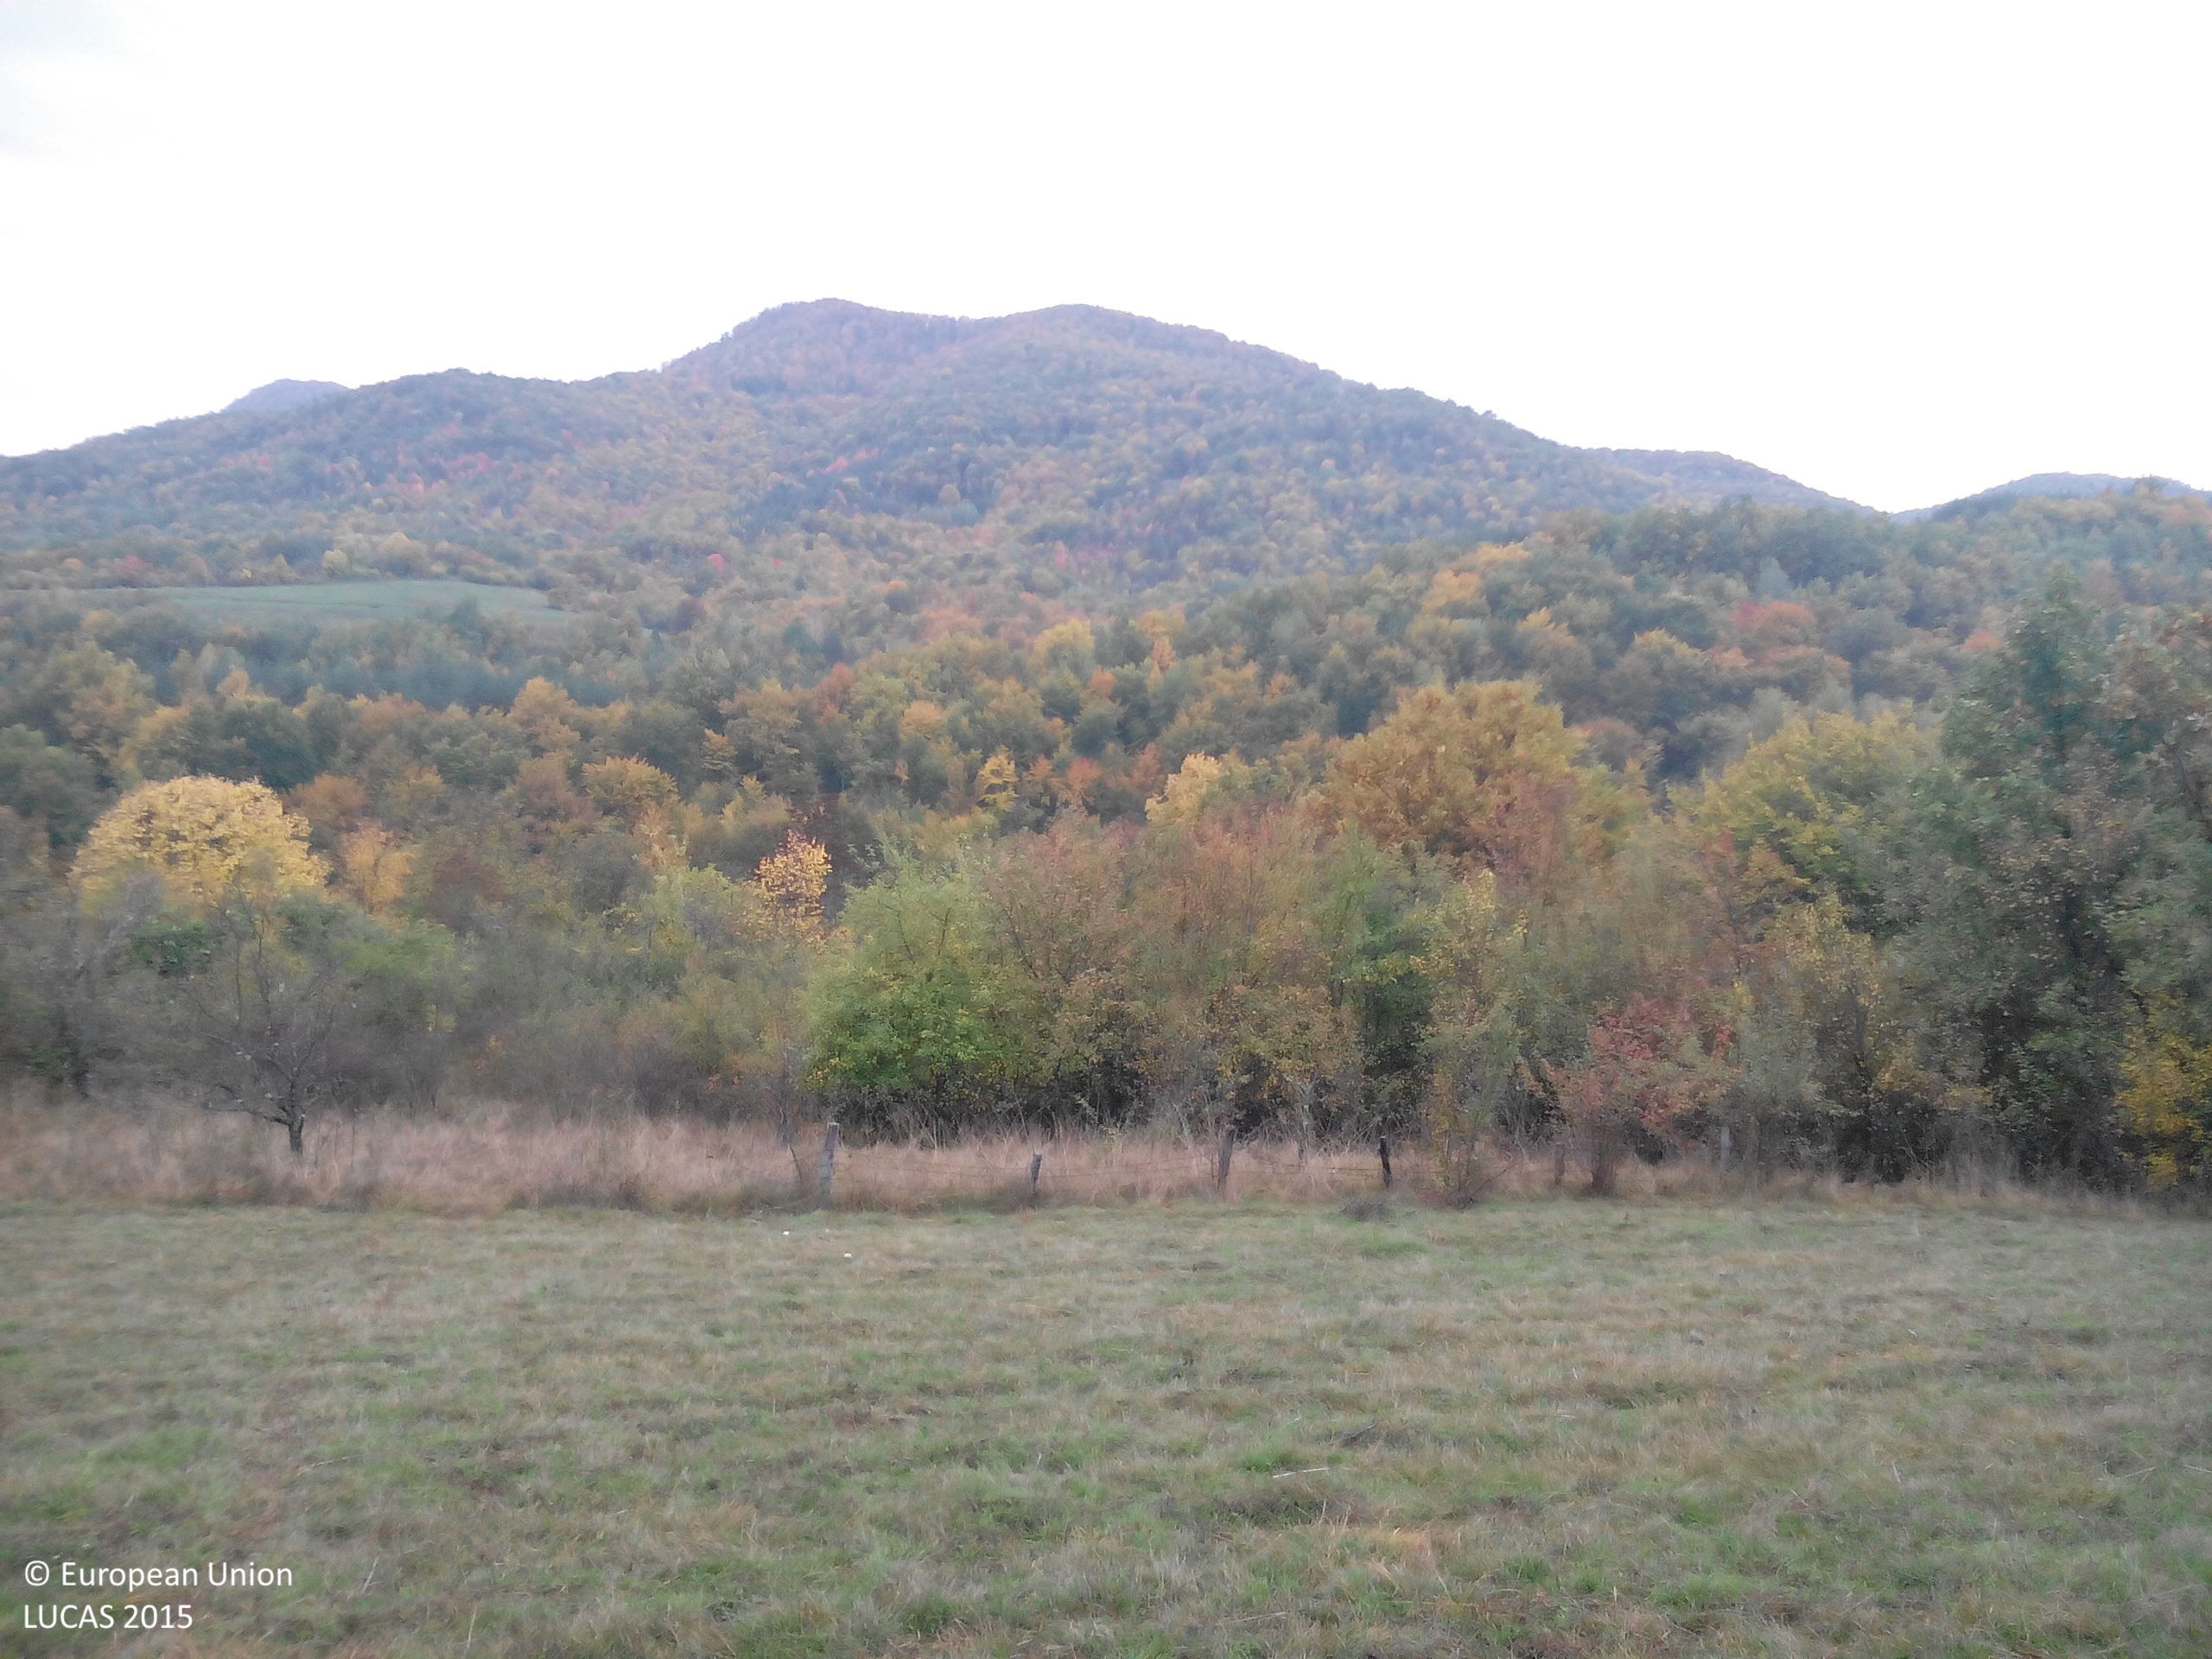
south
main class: Grassland
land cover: Grassland without tree/shrub cover
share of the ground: > 75 %
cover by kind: herbaceous plants 100 %
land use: Agriculture (excluding fallow land and kitchen gardens)
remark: Harvested field
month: October
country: BG
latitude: 42.9237
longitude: 23.9767
